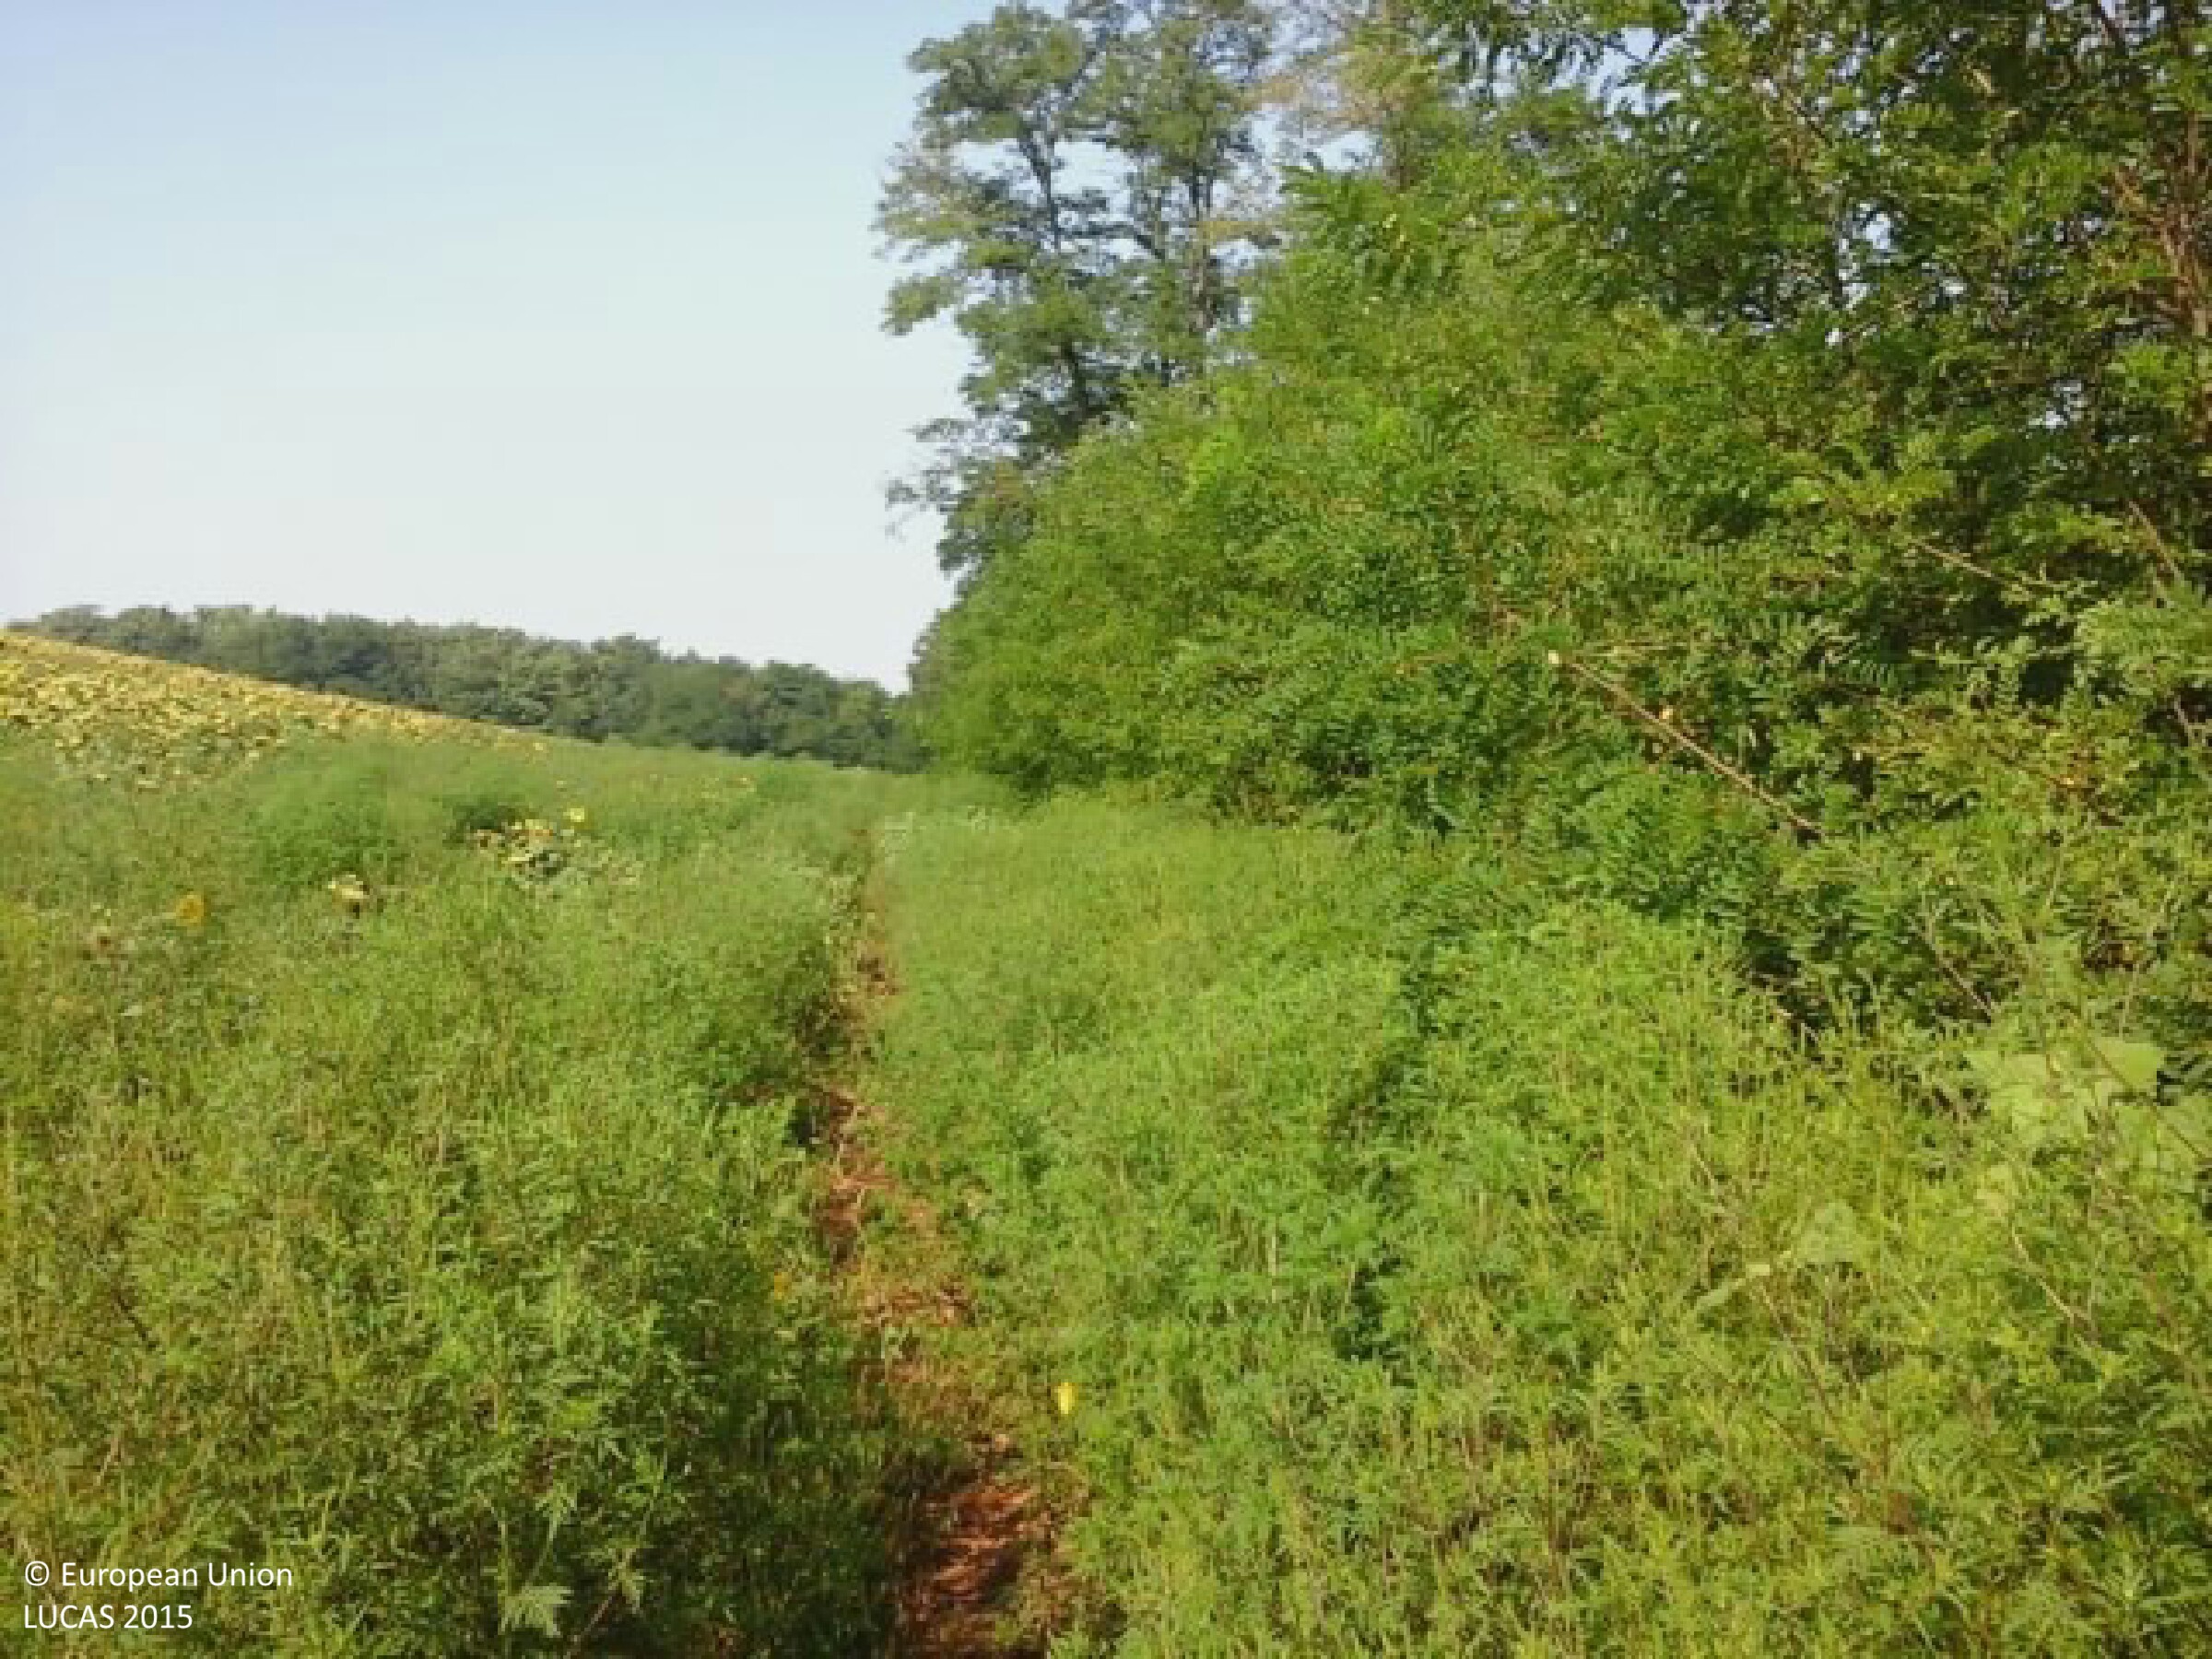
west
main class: Woodland
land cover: Broadleaved woodland
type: exotic forest
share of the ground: > 75 %
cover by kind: shrubs 60 %, broadleaved forest trees 40 %
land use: Abandoned areas
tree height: < 5 m
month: August
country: HU
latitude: 46.2954
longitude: 18.3559
